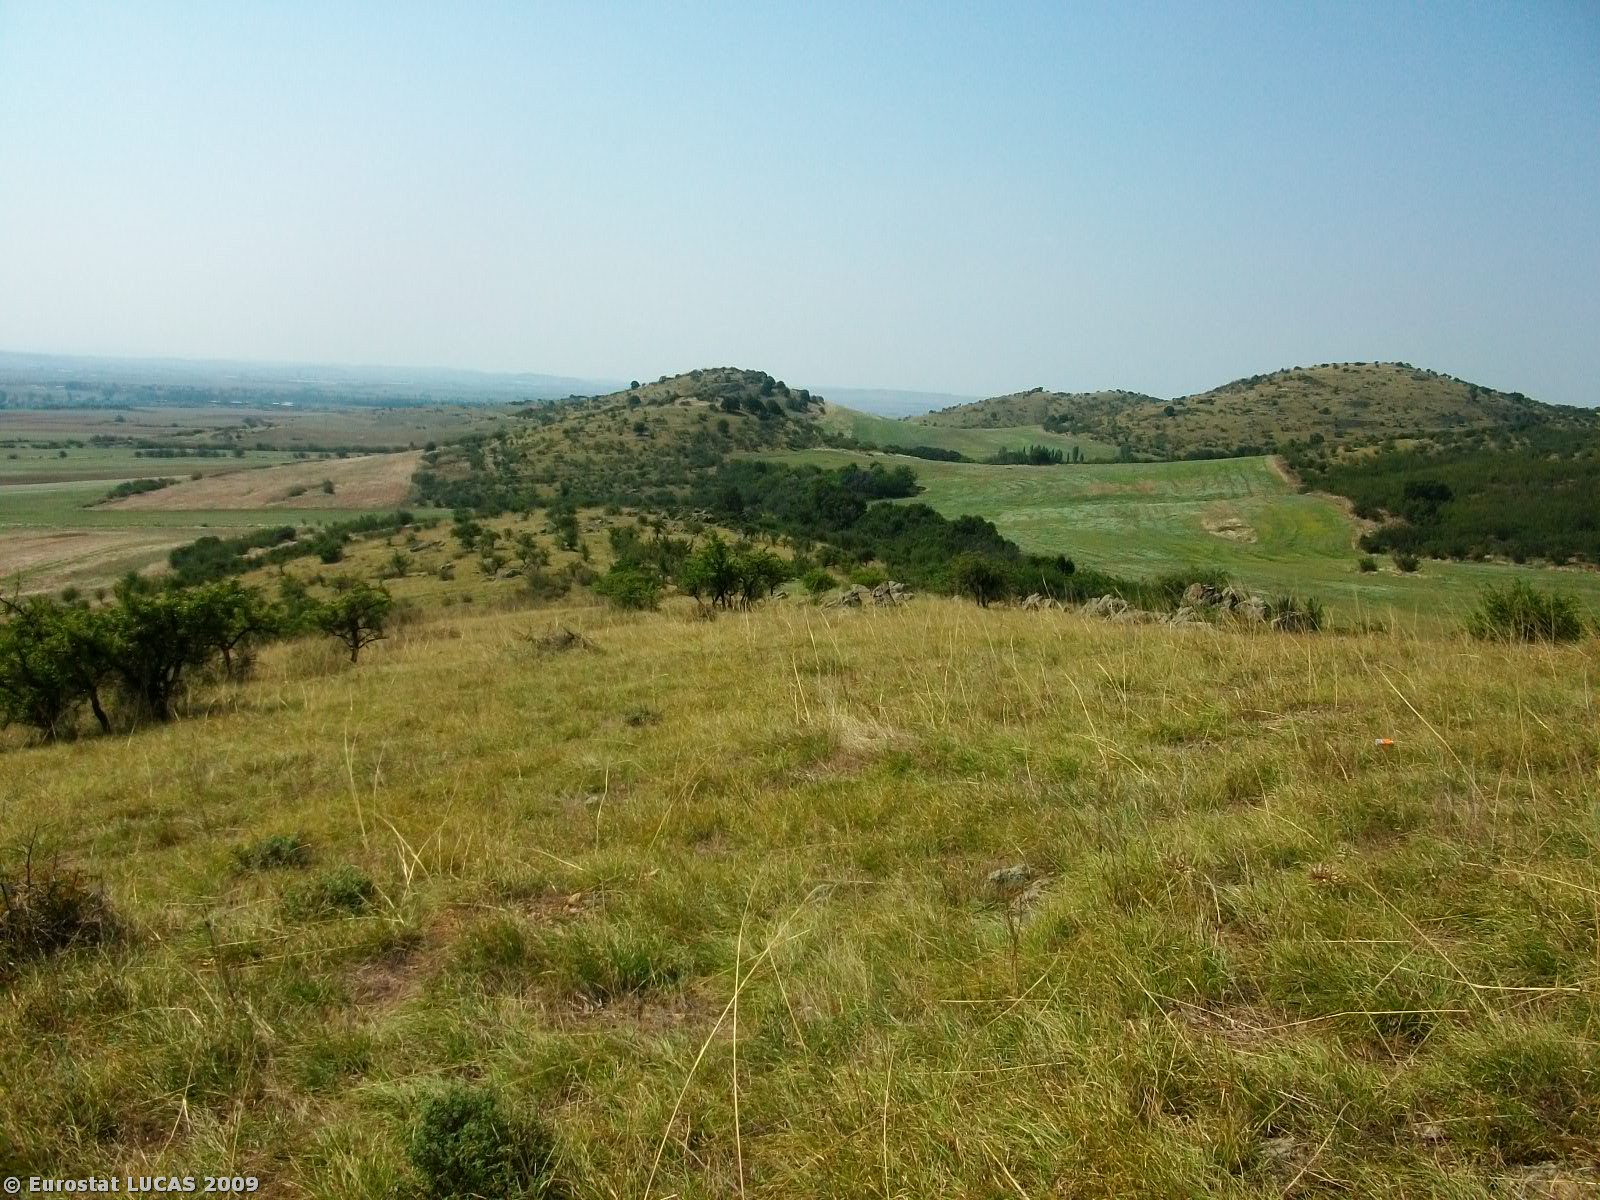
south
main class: Grassland
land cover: Grassland with sparse tree/shrub cover
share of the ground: > 75 %
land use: Unused
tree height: < 5 m
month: July
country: GR
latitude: 41.1298
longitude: 22.7683
